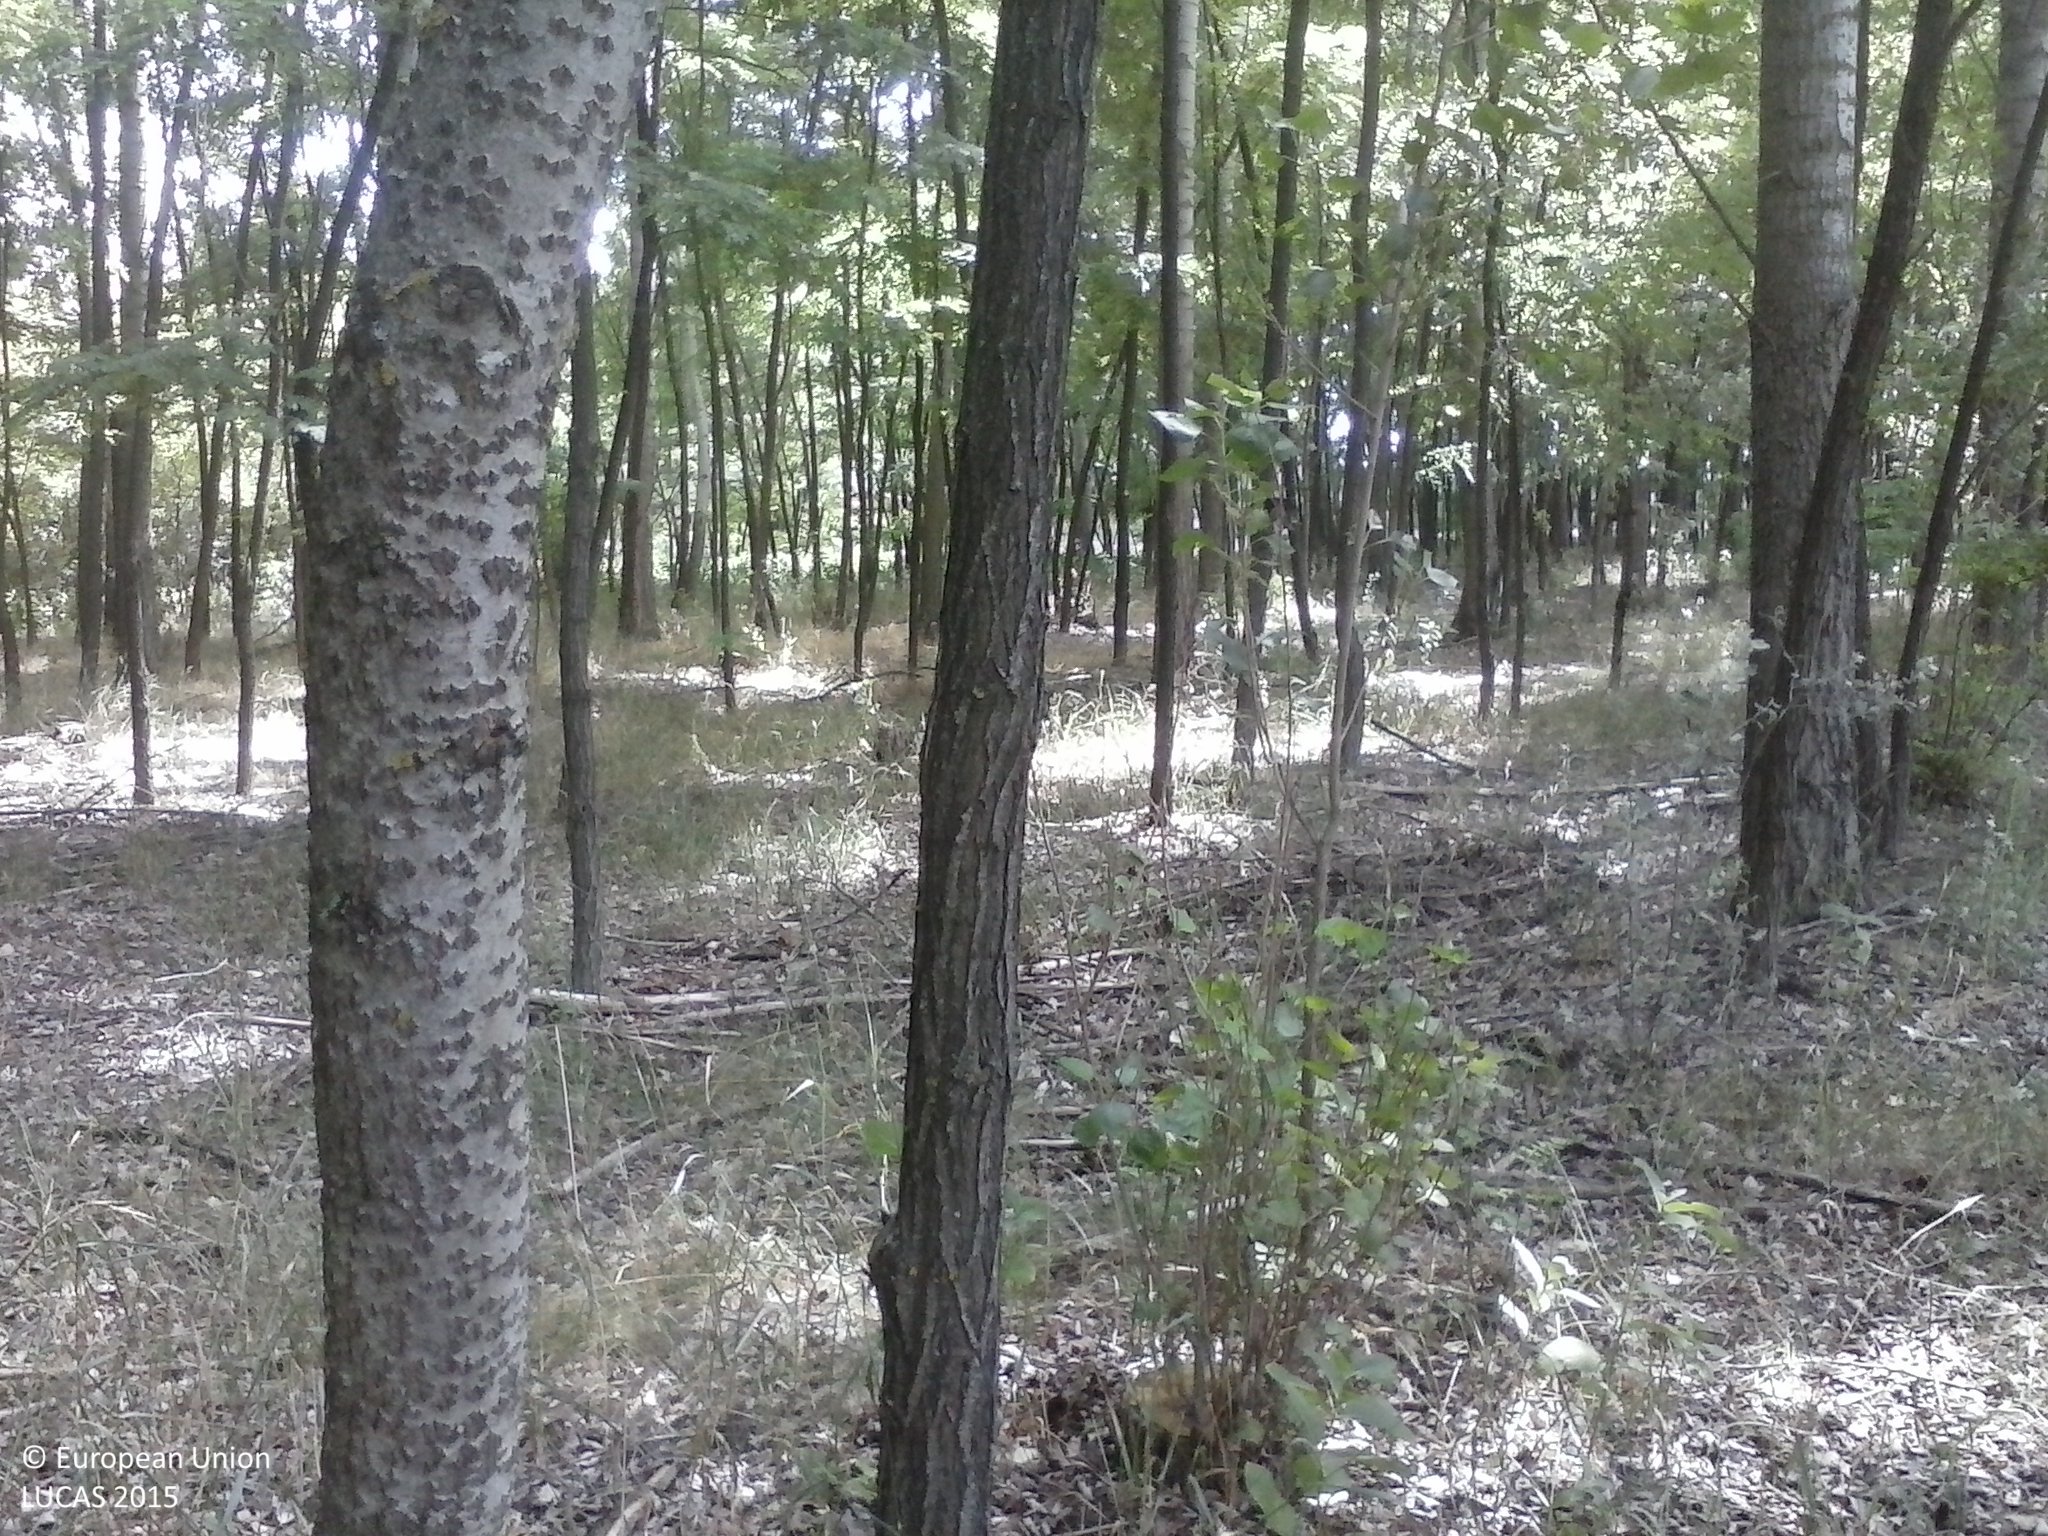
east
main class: Woodland
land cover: Broadleaved woodland
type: mesophytic deciduous forest
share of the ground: > 75 %
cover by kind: broadleaved forest trees 90 %, shrubs 5 %, herbaceous plants 5 %
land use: Forestry
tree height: > 5 m
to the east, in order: Broadleaved woodland; Artificial constructions in urban areas; Broadleaved woodland
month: July
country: HU
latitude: 46.6015
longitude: 19.6665
